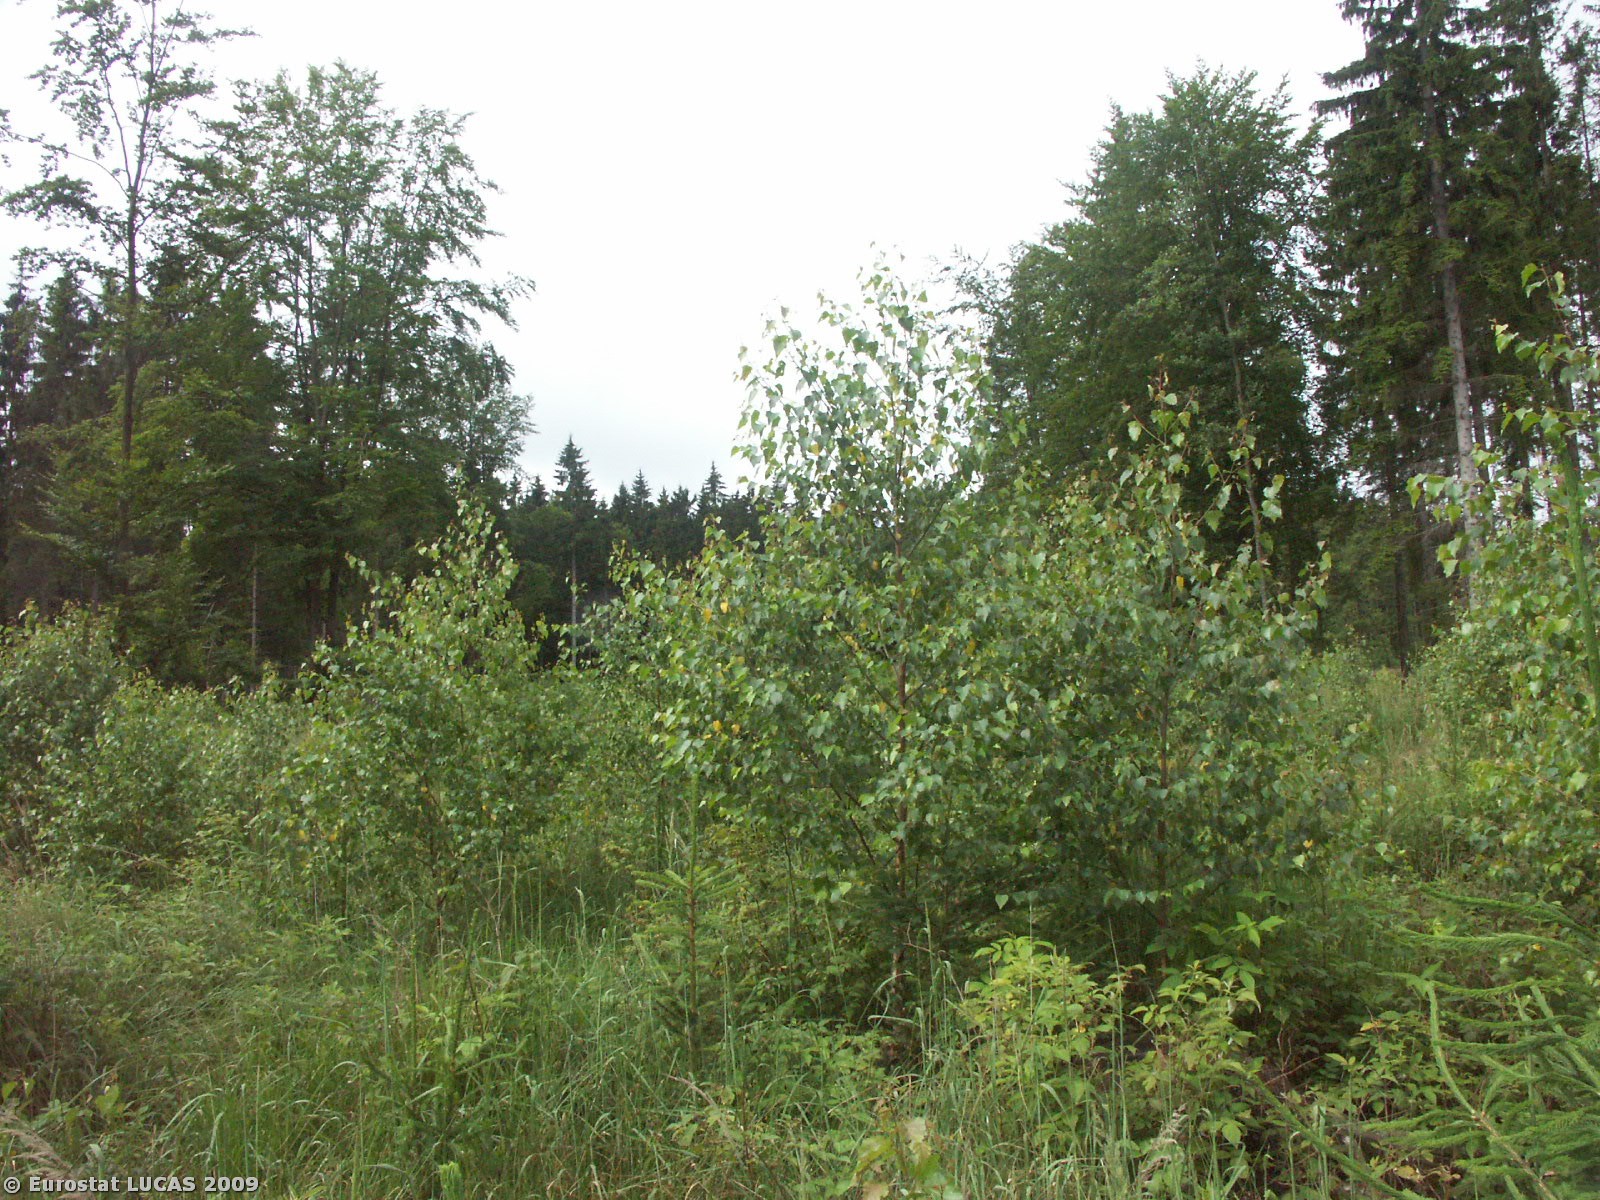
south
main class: Woodland
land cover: Mixed woodland
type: hemiboreal forest and nemoral coniferous forest and mixed broadleaved-coniferous forest
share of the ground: > 75 %
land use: Forestry
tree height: > 5 m
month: July
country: CZ
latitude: 49.9035
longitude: 17.4610
